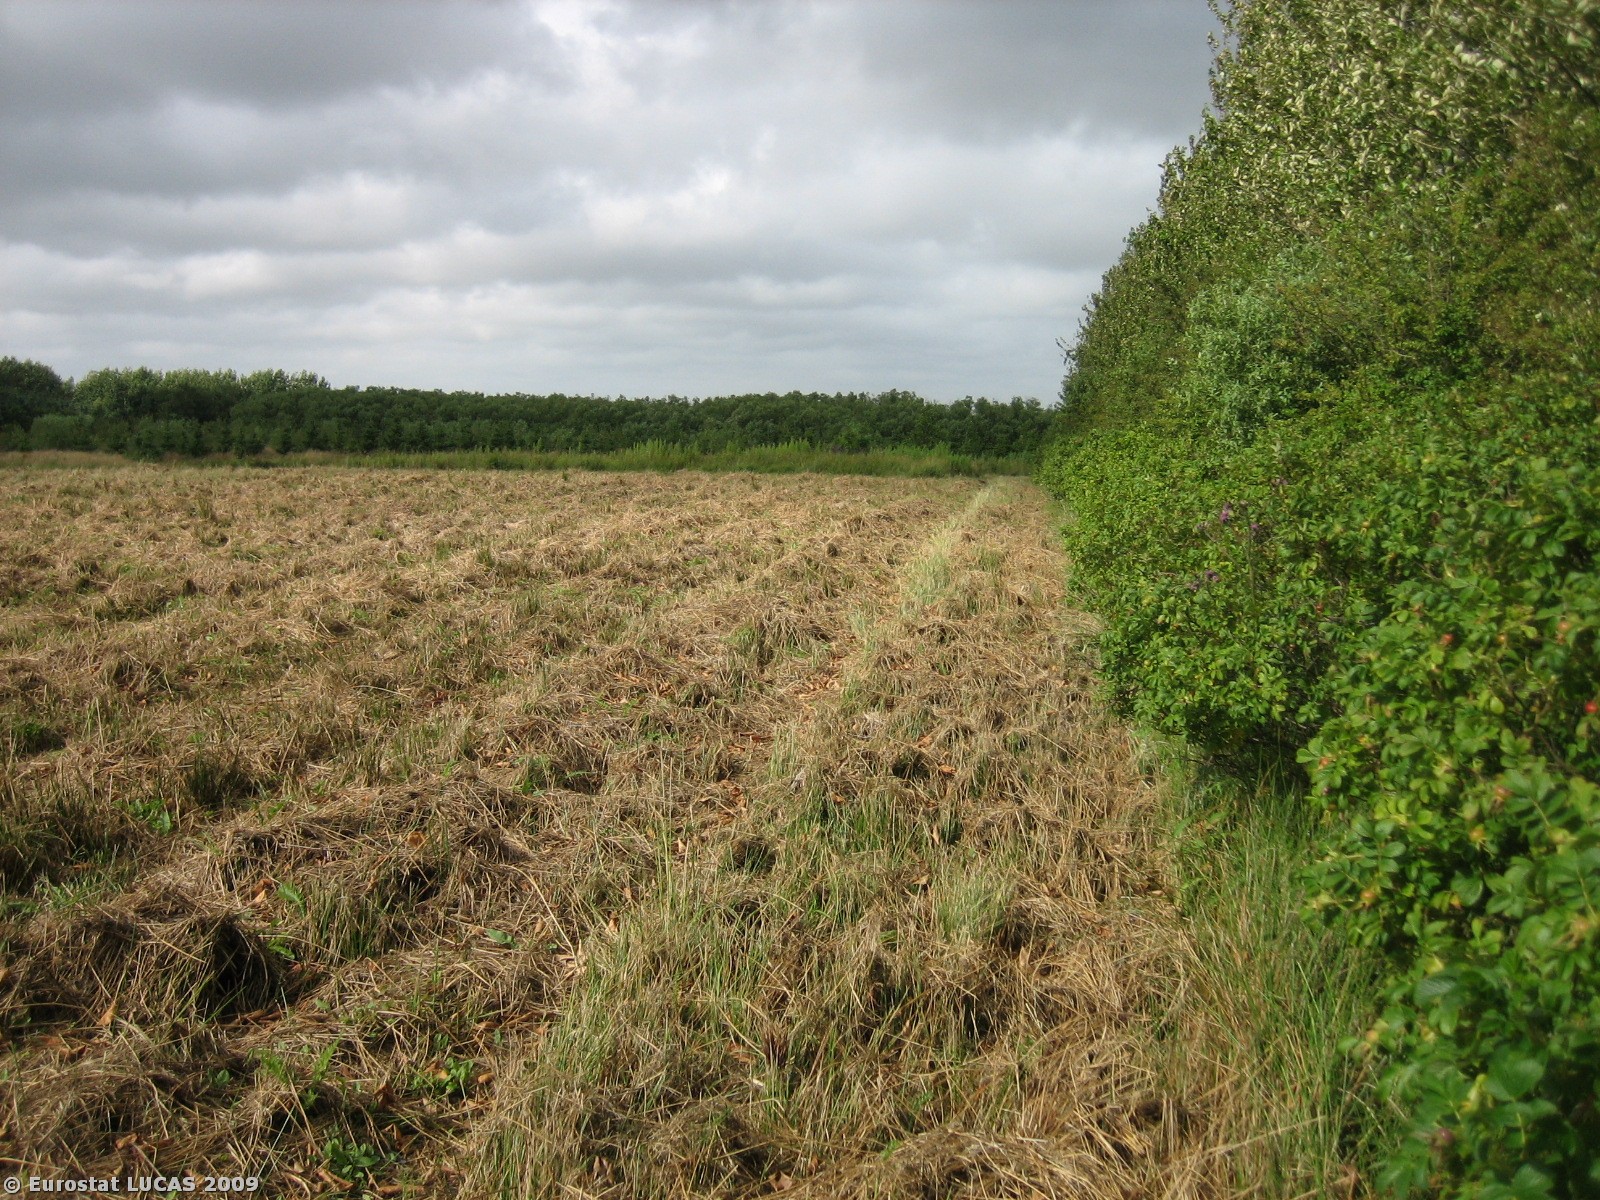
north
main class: Grassland
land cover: Grassland without tree/shrub cover
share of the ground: > 75 %
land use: Agriculture (excluding fallow land and kitchen gardens)
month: July
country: DK
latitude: 55.6551
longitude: 8.3010
